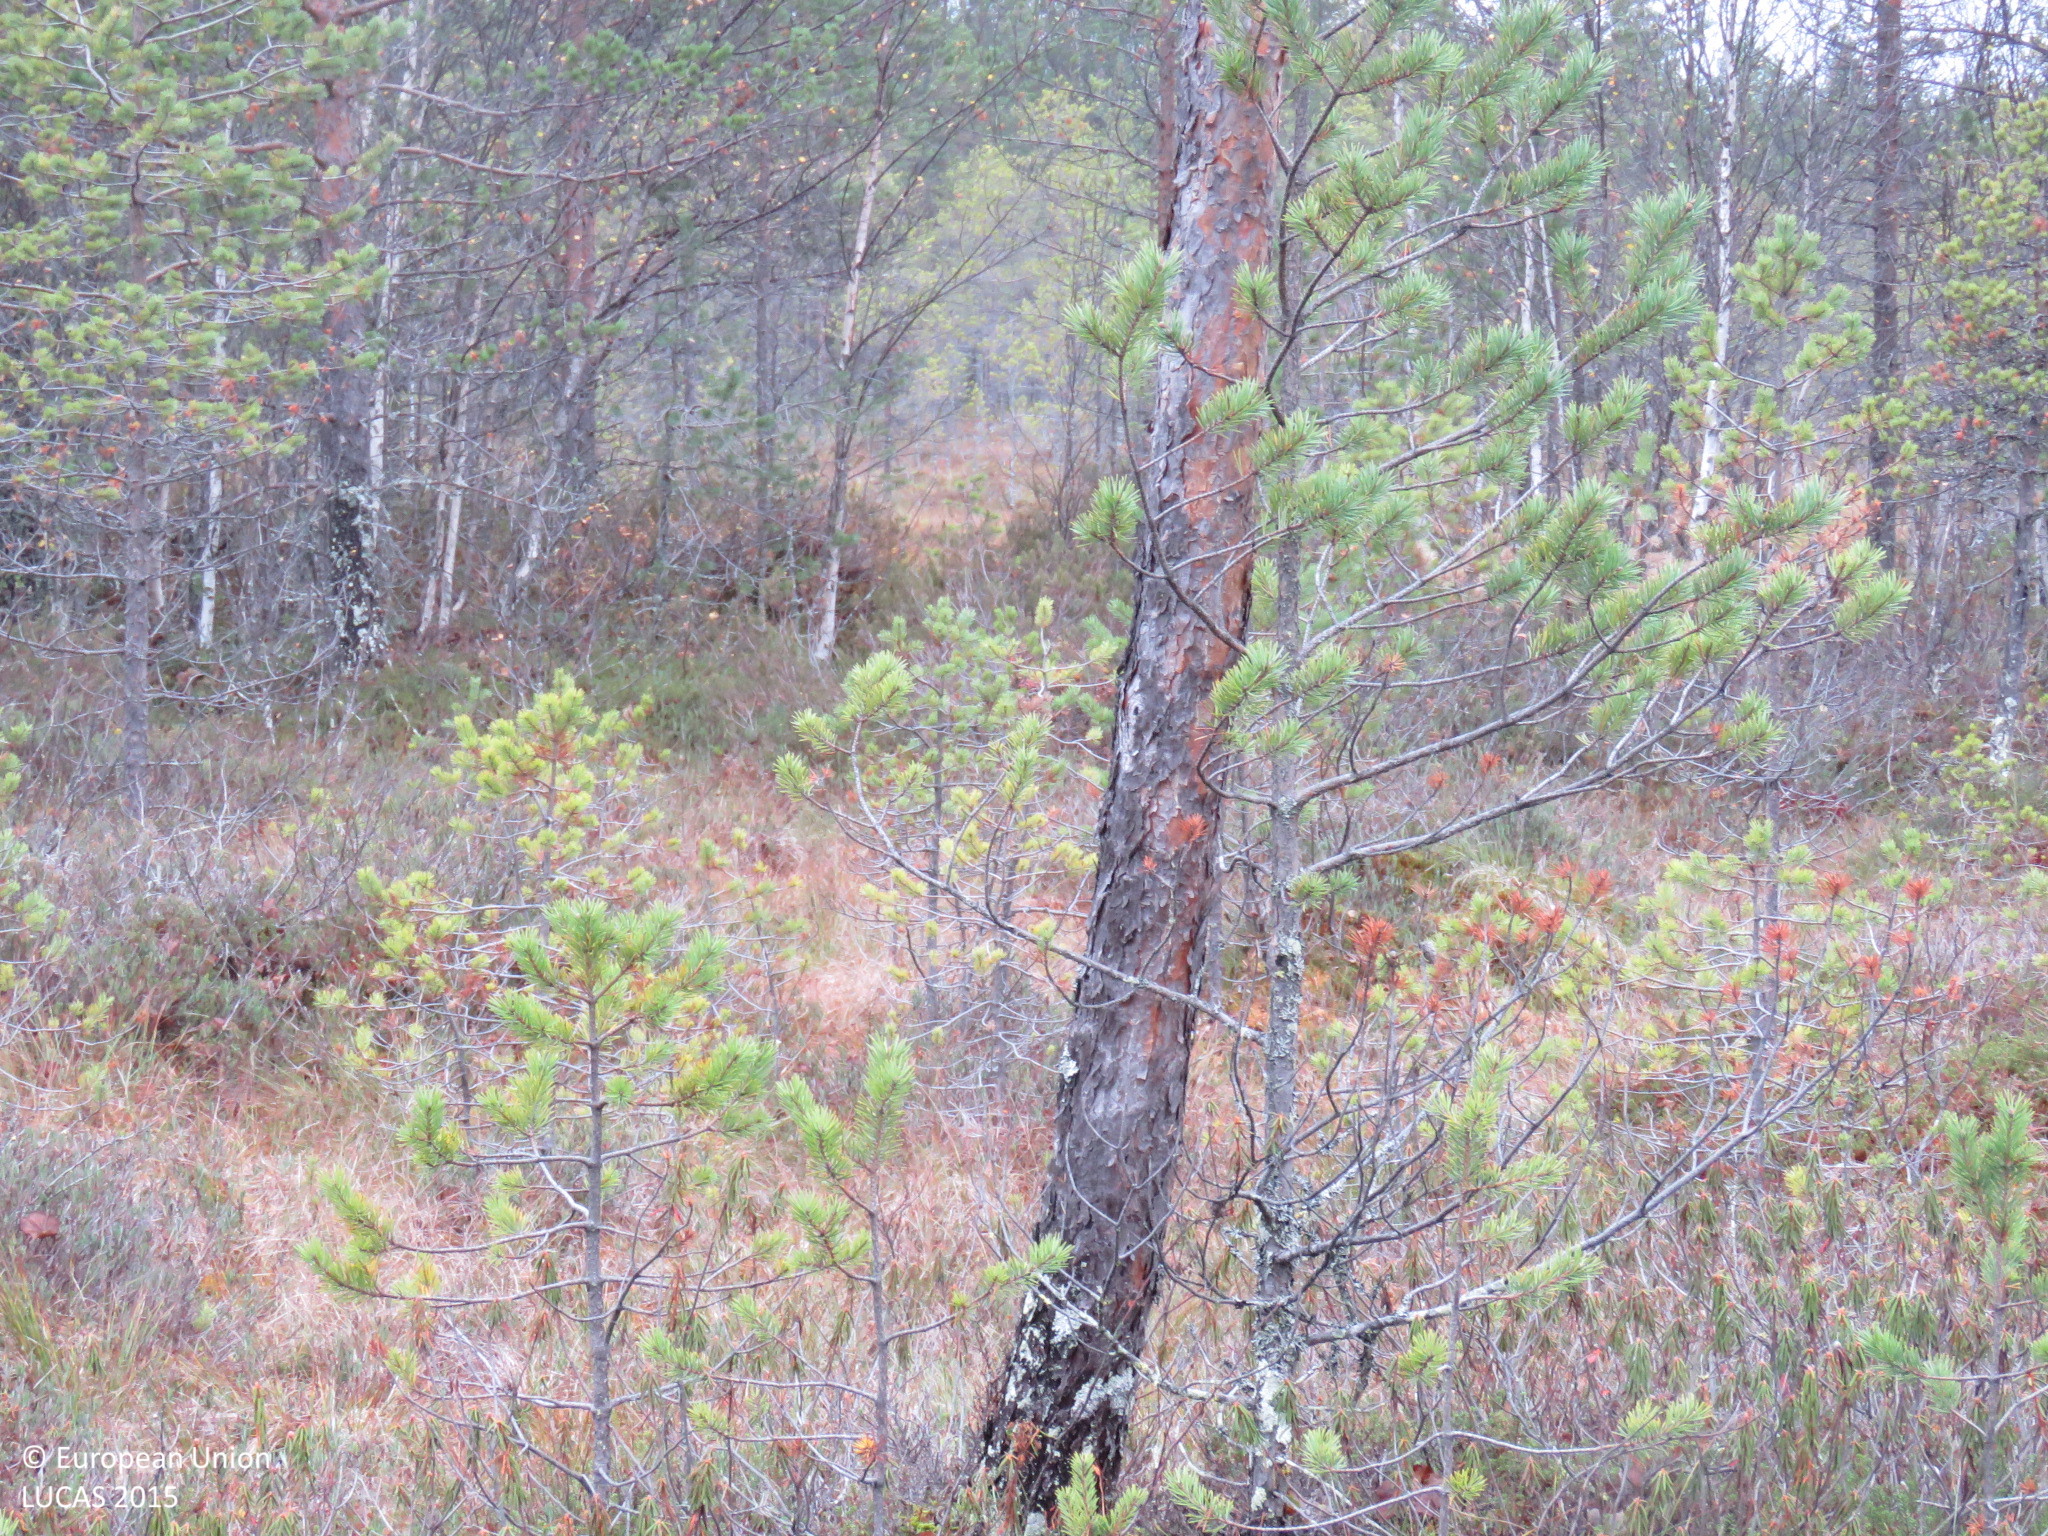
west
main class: Woodland
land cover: Pine dominated coniferous woodland
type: mire and swamp forests
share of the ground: 25 - 50 %
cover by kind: coniferous forest trees 45 %, shrubs 25 %, herbaceous plants 20 %, lichens and mosses 10 %
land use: Forestry
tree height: < 5 m
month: September
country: FI
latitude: 65.2751
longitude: 26.8043
